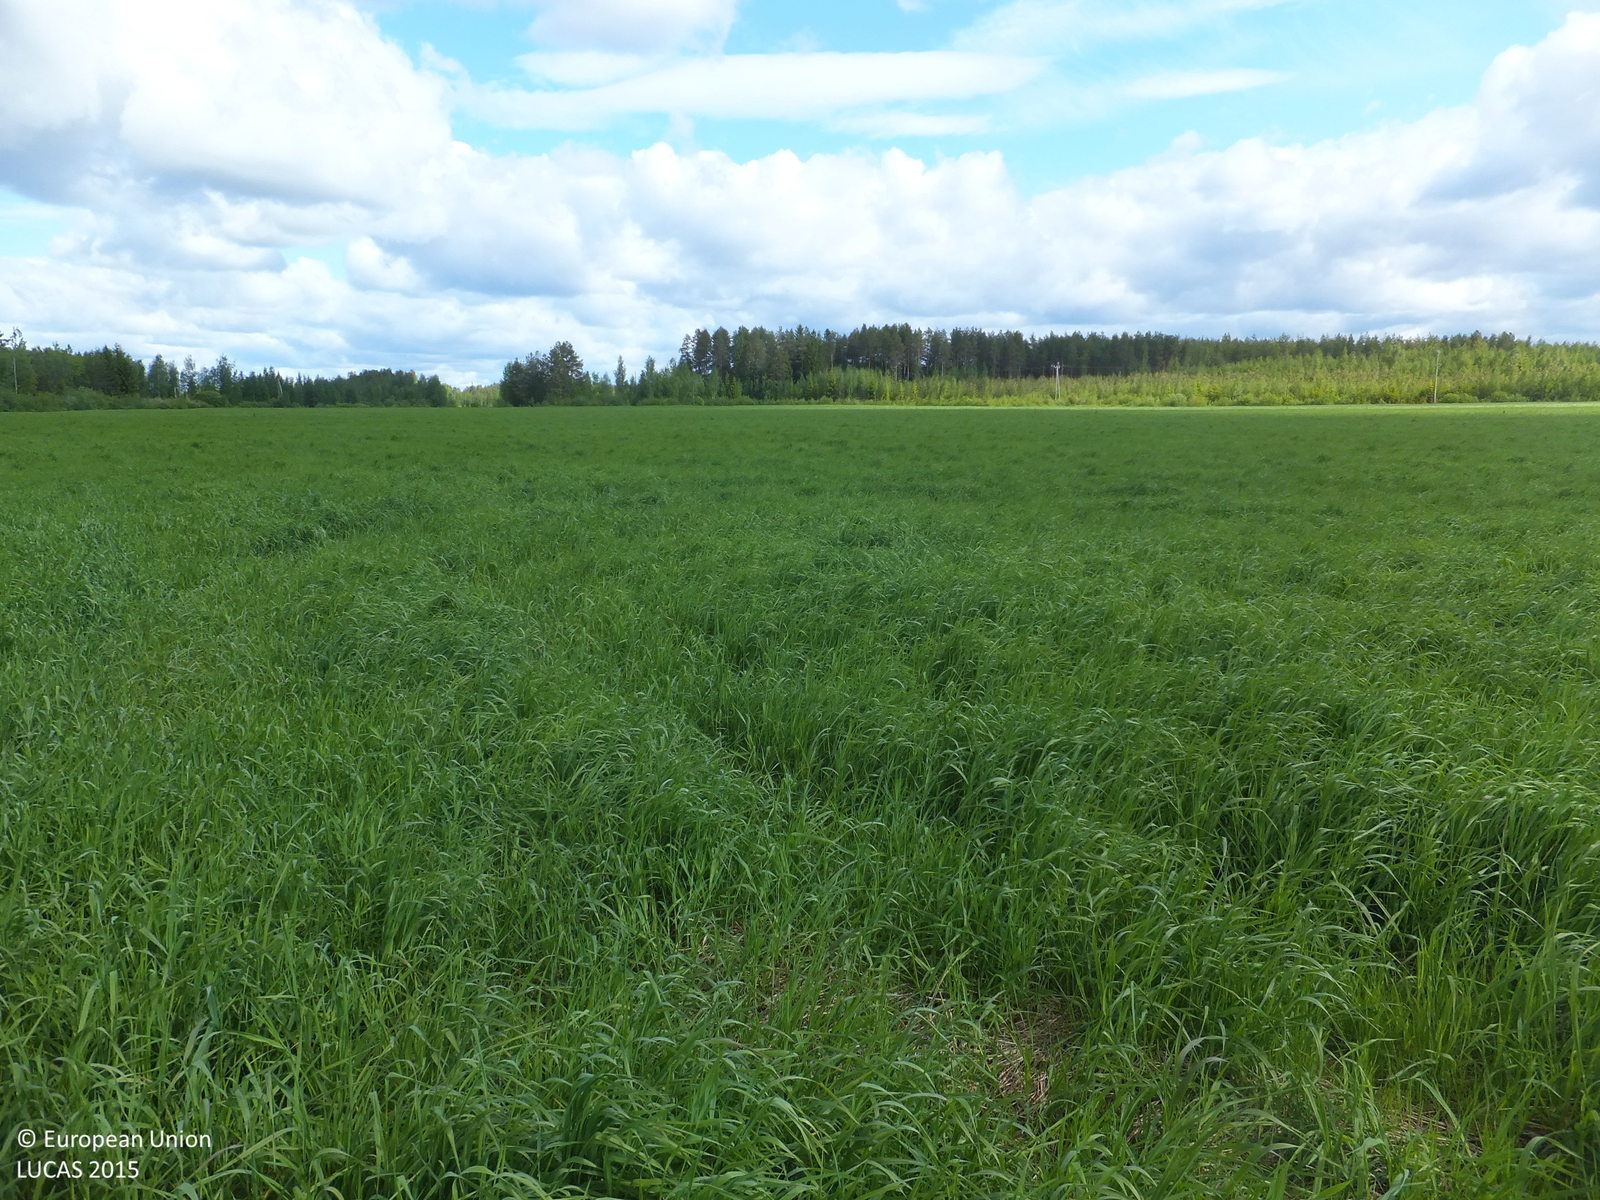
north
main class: Cropland
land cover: Temporary grasslands
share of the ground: > 75 %
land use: Agriculture (excluding fallow land and kitchen gardens)
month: June
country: FI
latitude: 63.5341
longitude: 24.7871
